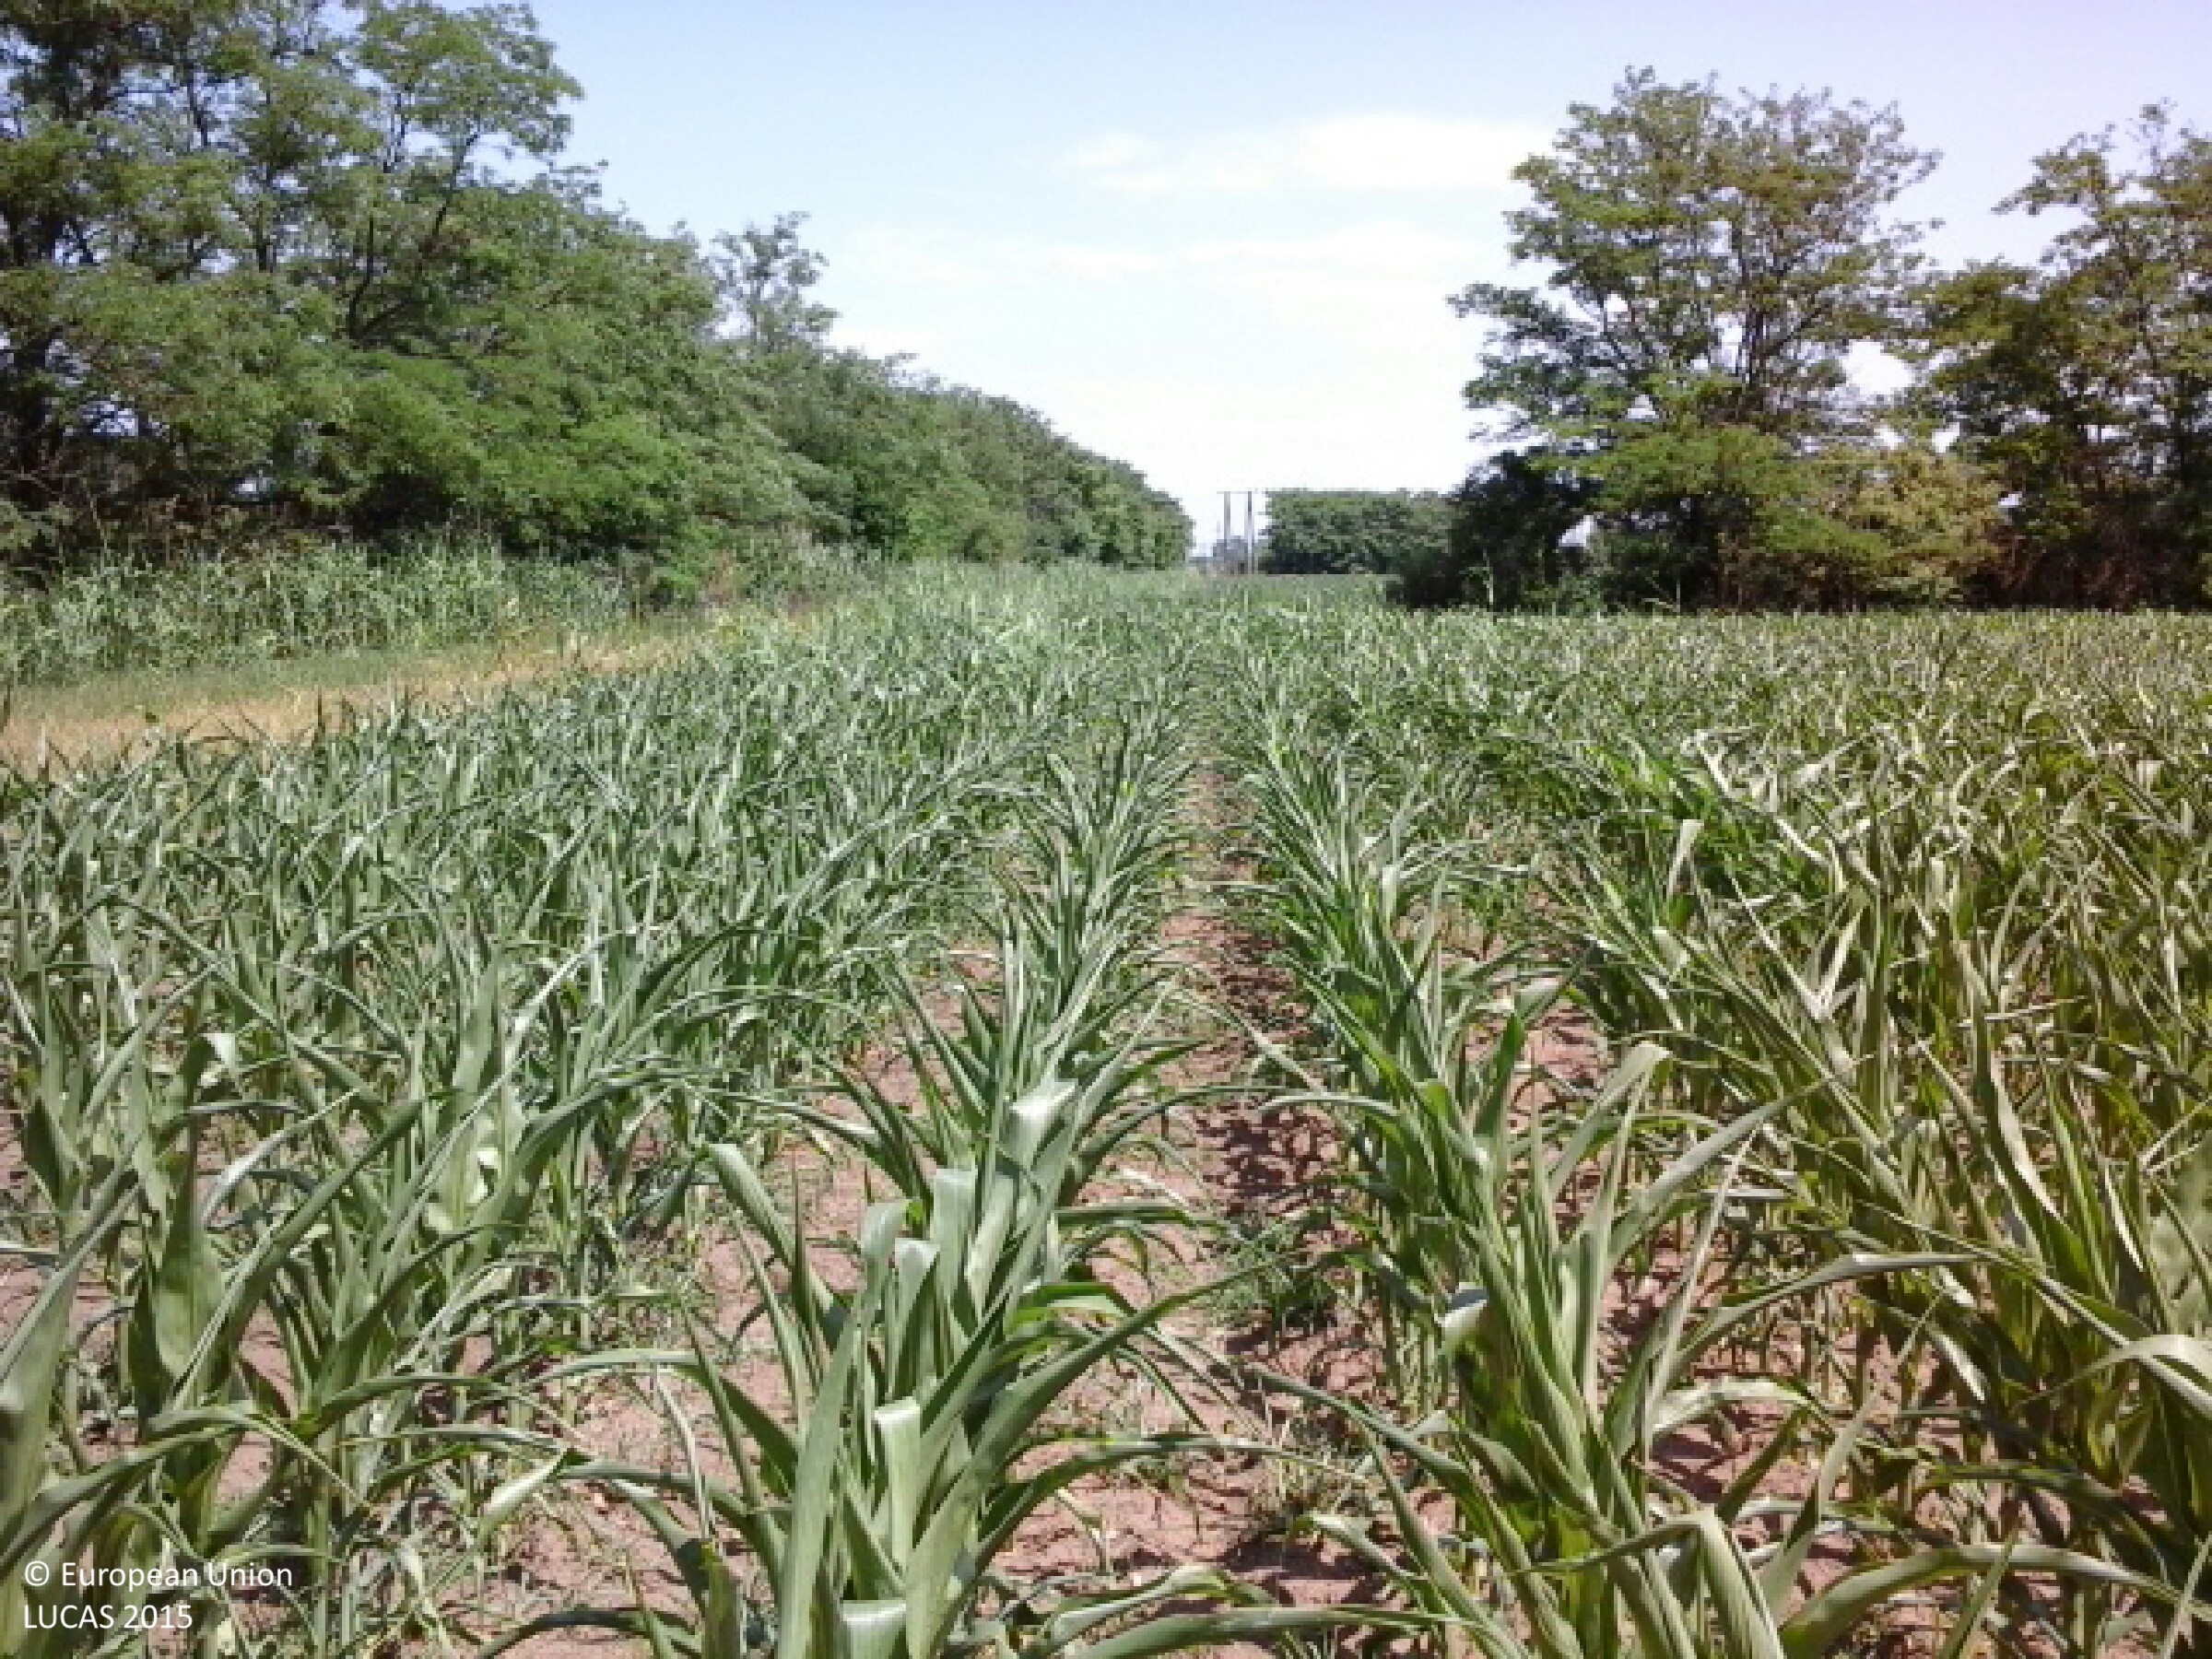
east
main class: Cropland
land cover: Maize
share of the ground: 50 - 75 %
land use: Agriculture (excluding fallow land and kitchen gardens)
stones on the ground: < 10 %
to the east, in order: Maize; Abandoned hedges; Maize
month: June
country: HU
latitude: 47.8539
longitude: 21.6879
